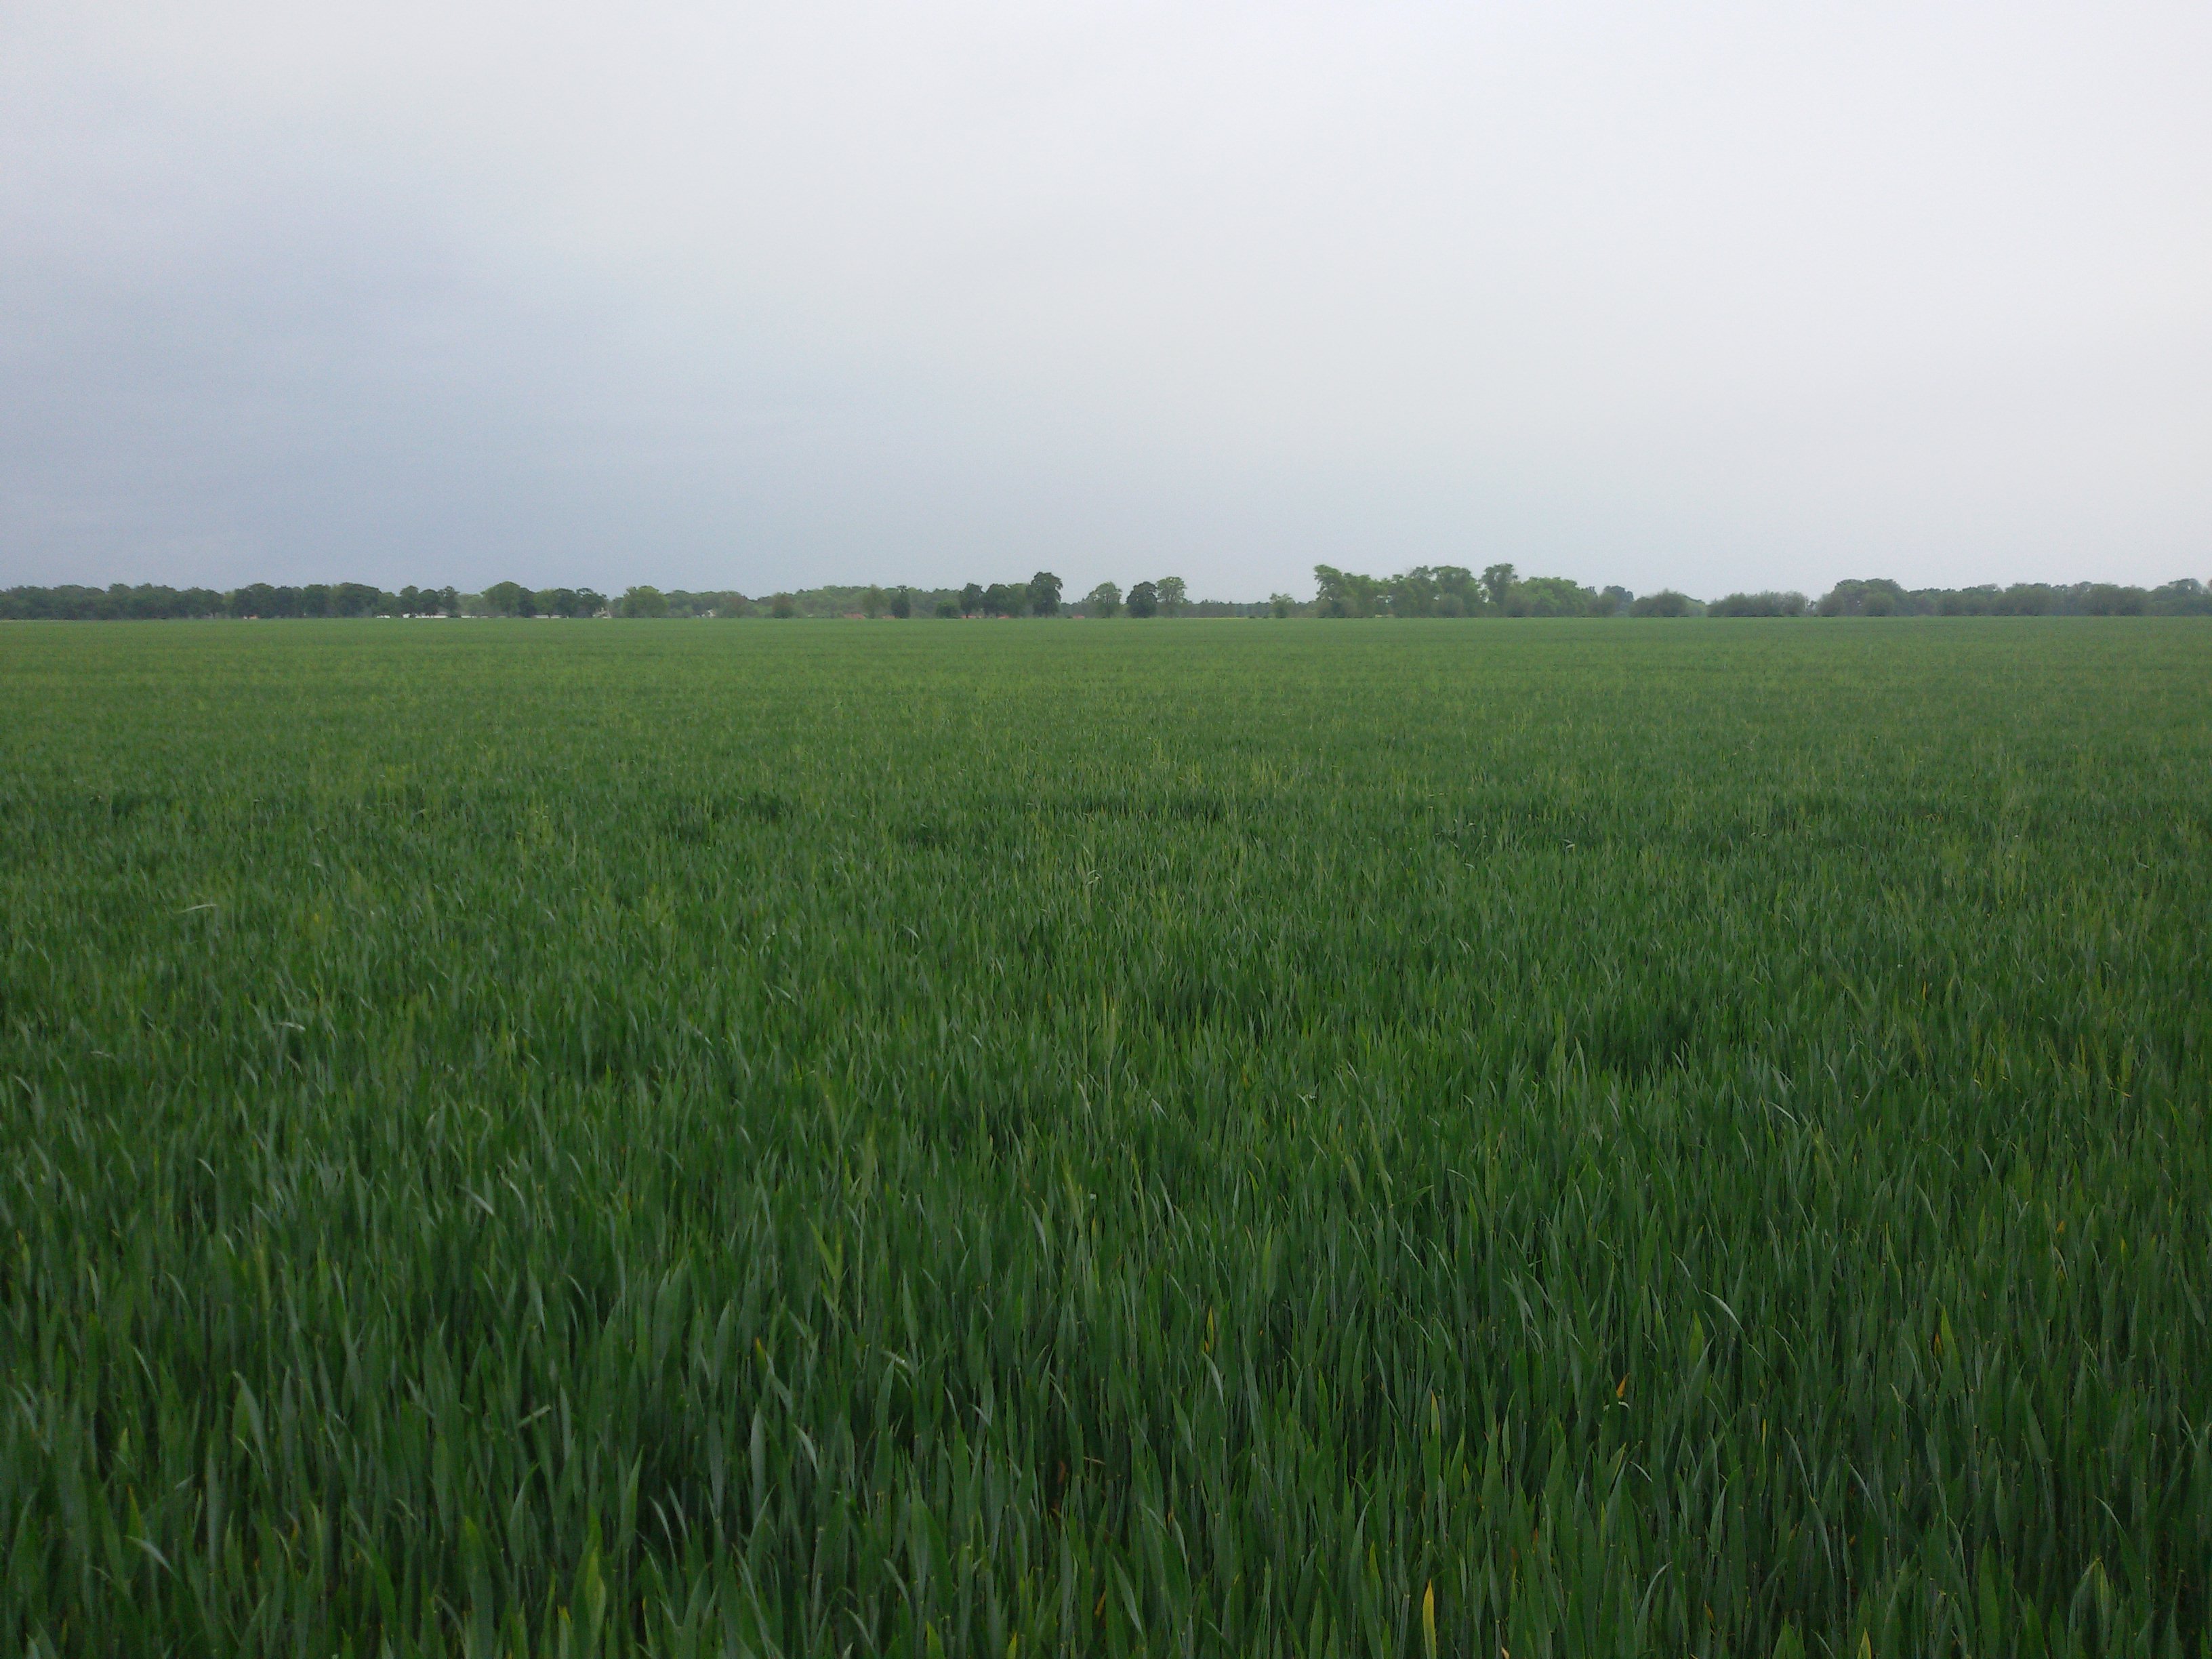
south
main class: Cropland
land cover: Common wheat
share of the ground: > 75 %
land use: Agriculture (excluding fallow land and kitchen gardens)
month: May
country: PL
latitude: 52.1428
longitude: 16.8625
